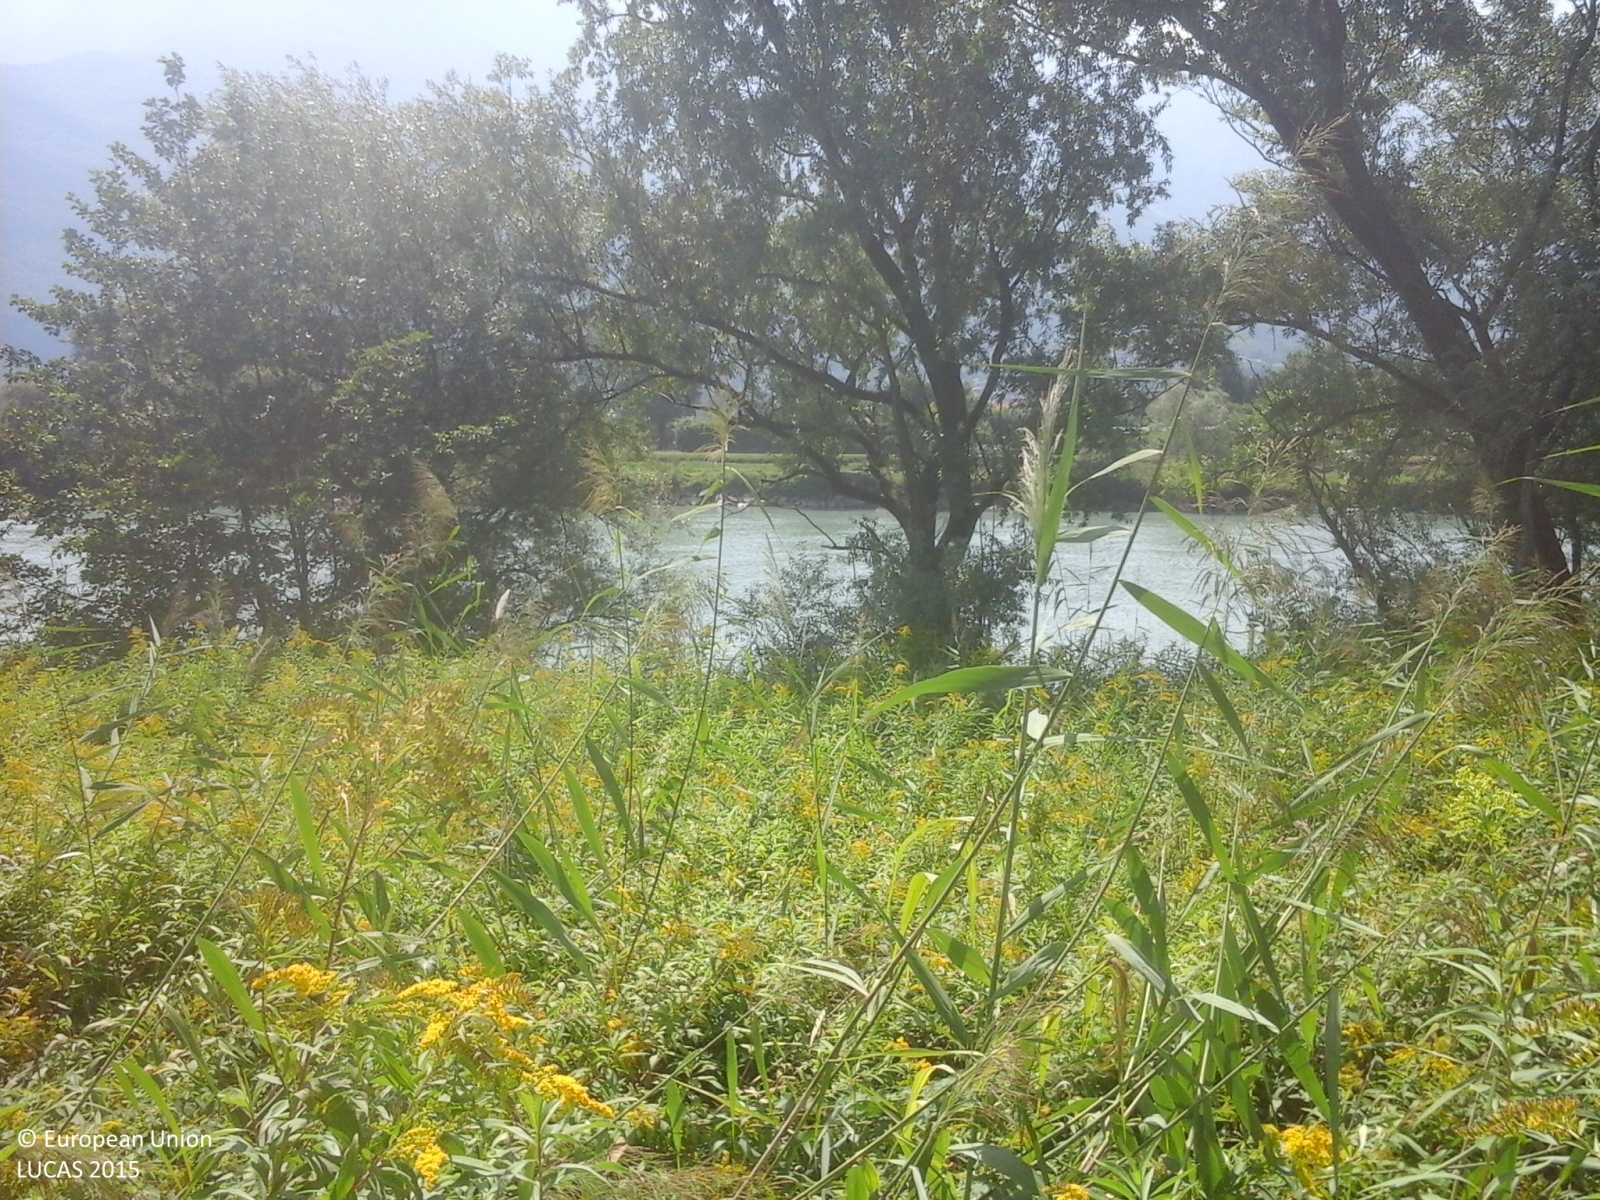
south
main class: Woodland
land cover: Broadleaved woodland
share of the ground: > 75 %
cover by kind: broadleaved forest trees 90 %, shrubs 5 %, herbaceous plants 5 %
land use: Semi-natural and natural areas not in use
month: August
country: IT
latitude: 46.1513
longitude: 9.3923
